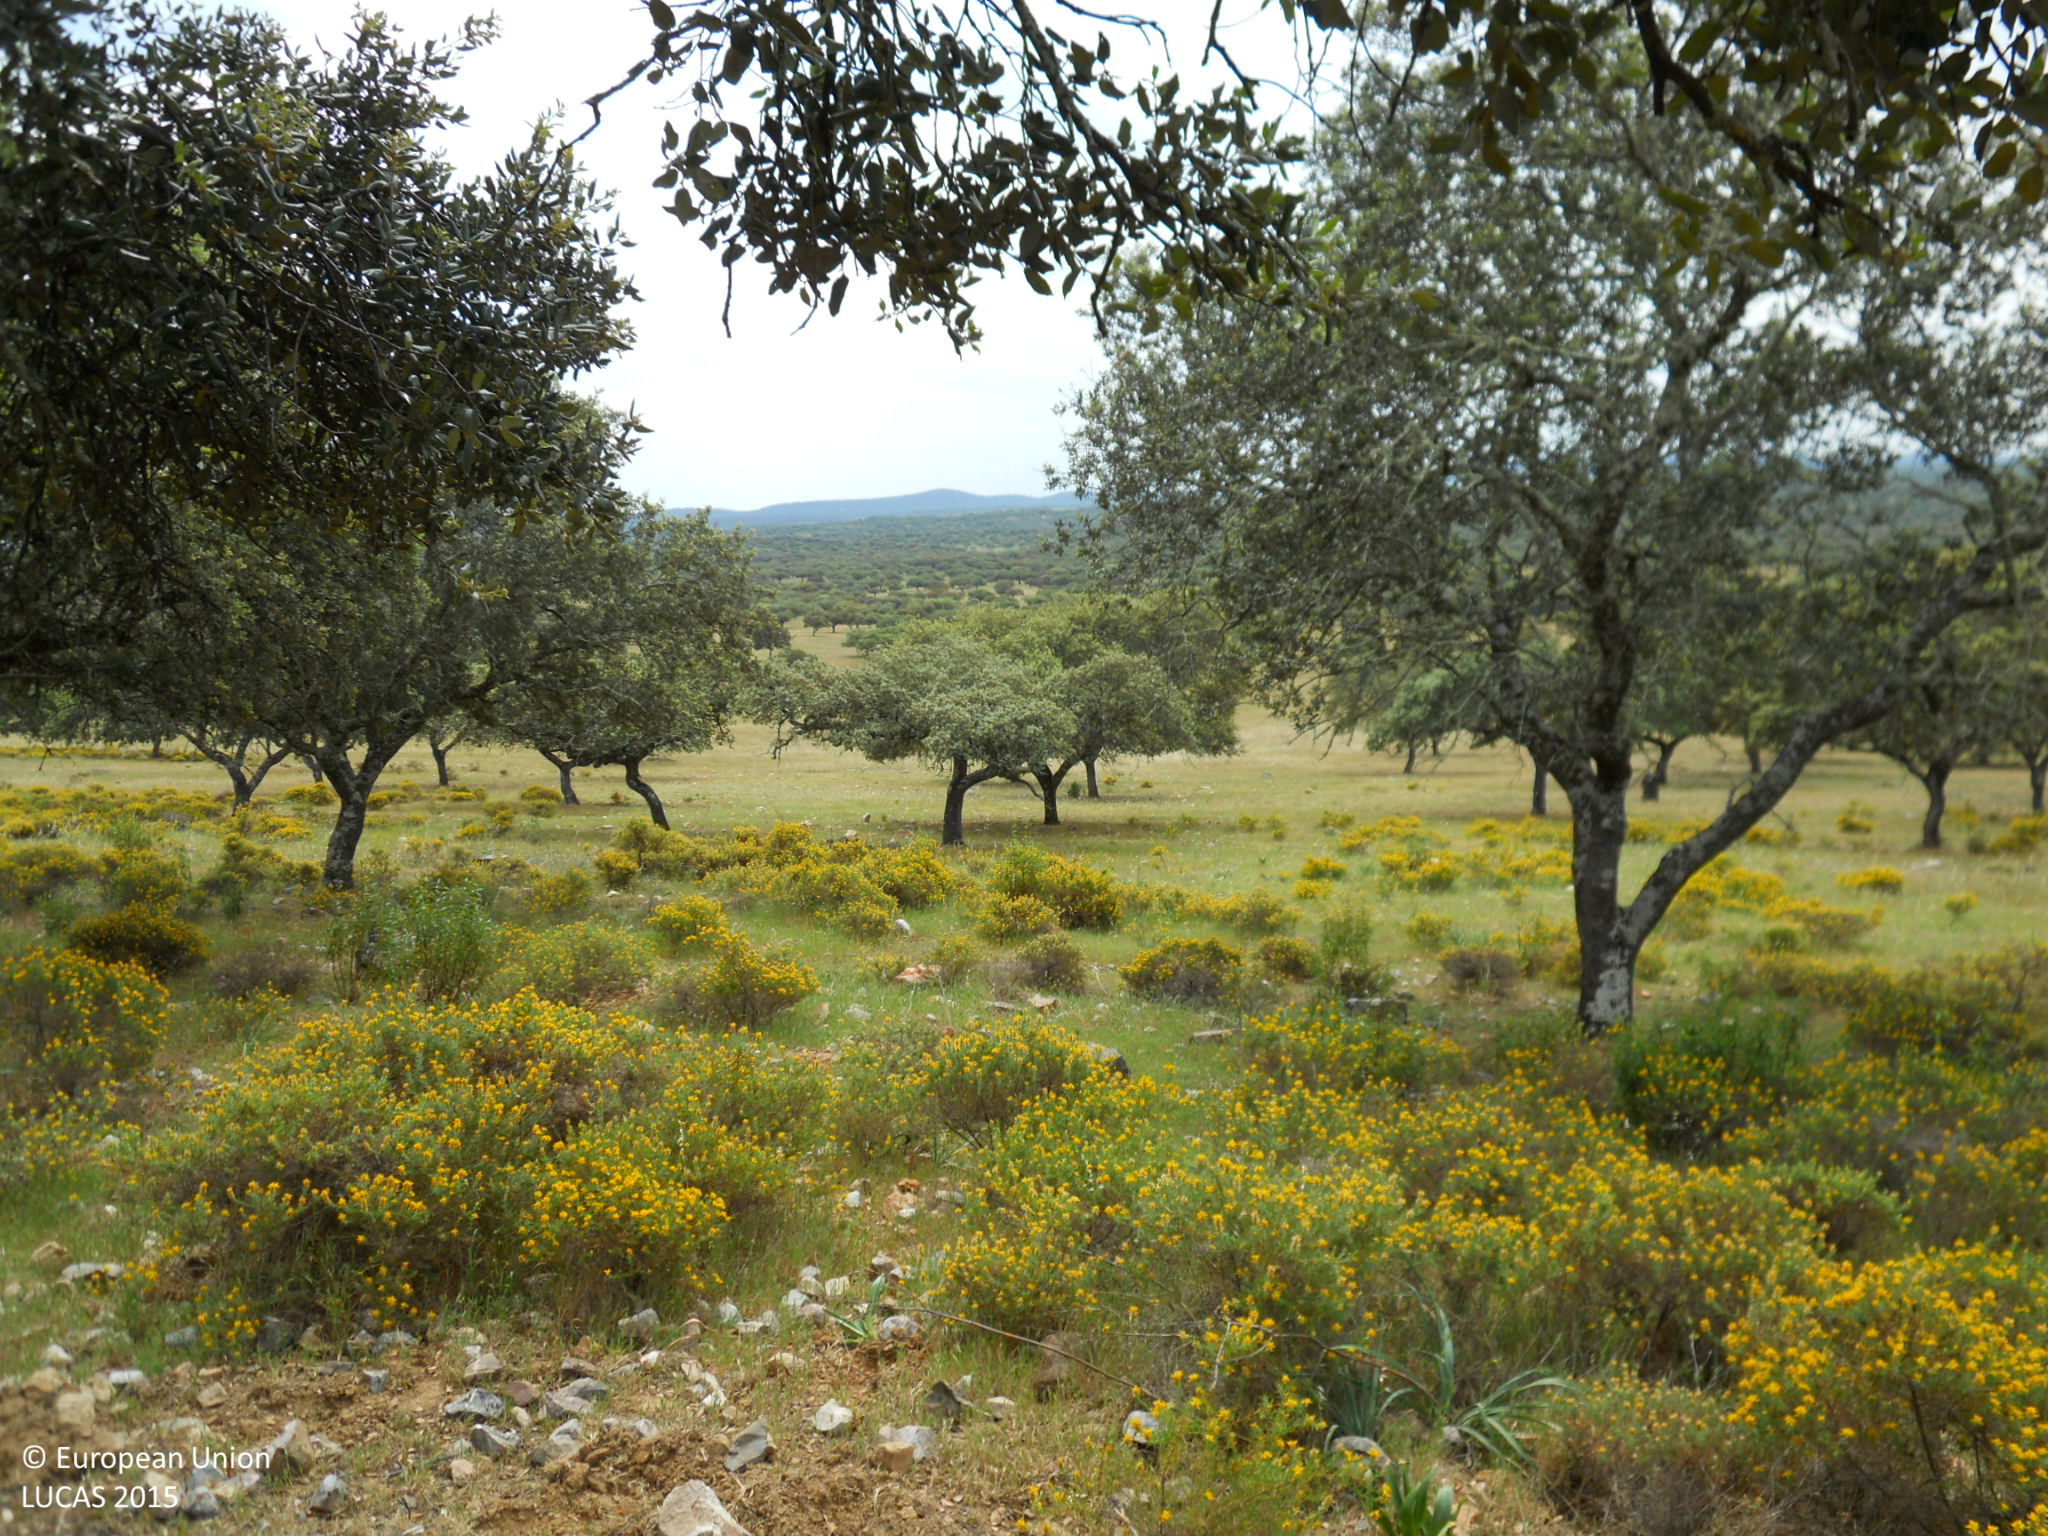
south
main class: Woodland
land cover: Broadleaved woodland
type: broadleaved evergreen forest
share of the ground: 25 - 50 %
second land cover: Shrubland without tree cover
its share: > 75 %
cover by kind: broadleaved forest trees 90 %, shrubs 5 %, herbaceous plants 5 %
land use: Forestry
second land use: Agriculture (excluding fallow land and kitchen gardens)
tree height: > 5 m
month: April
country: ES
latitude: 39.3266
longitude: -6.8848
